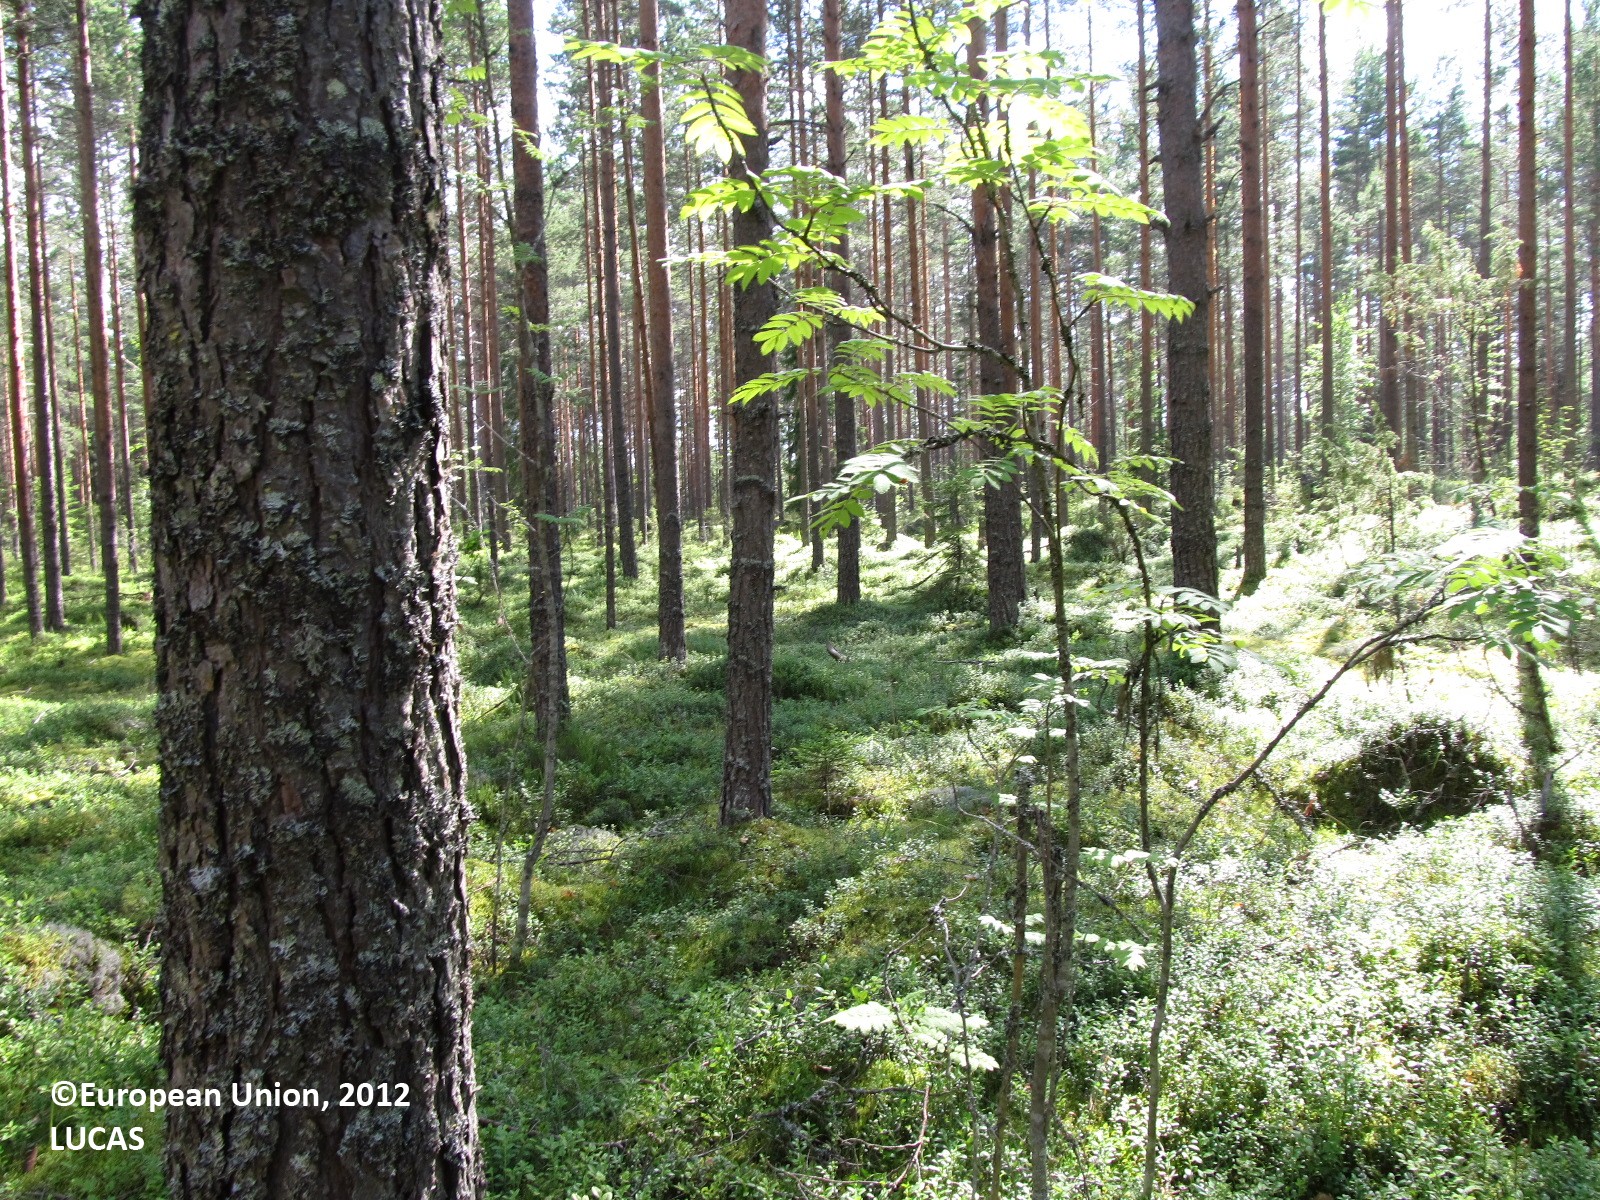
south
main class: Woodland
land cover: Pine dominated coniferous woodland
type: boreal forest
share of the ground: 50 - 75 %
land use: Forestry
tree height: > 5 m
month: July
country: FI
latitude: 61.8698
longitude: 27.9662
